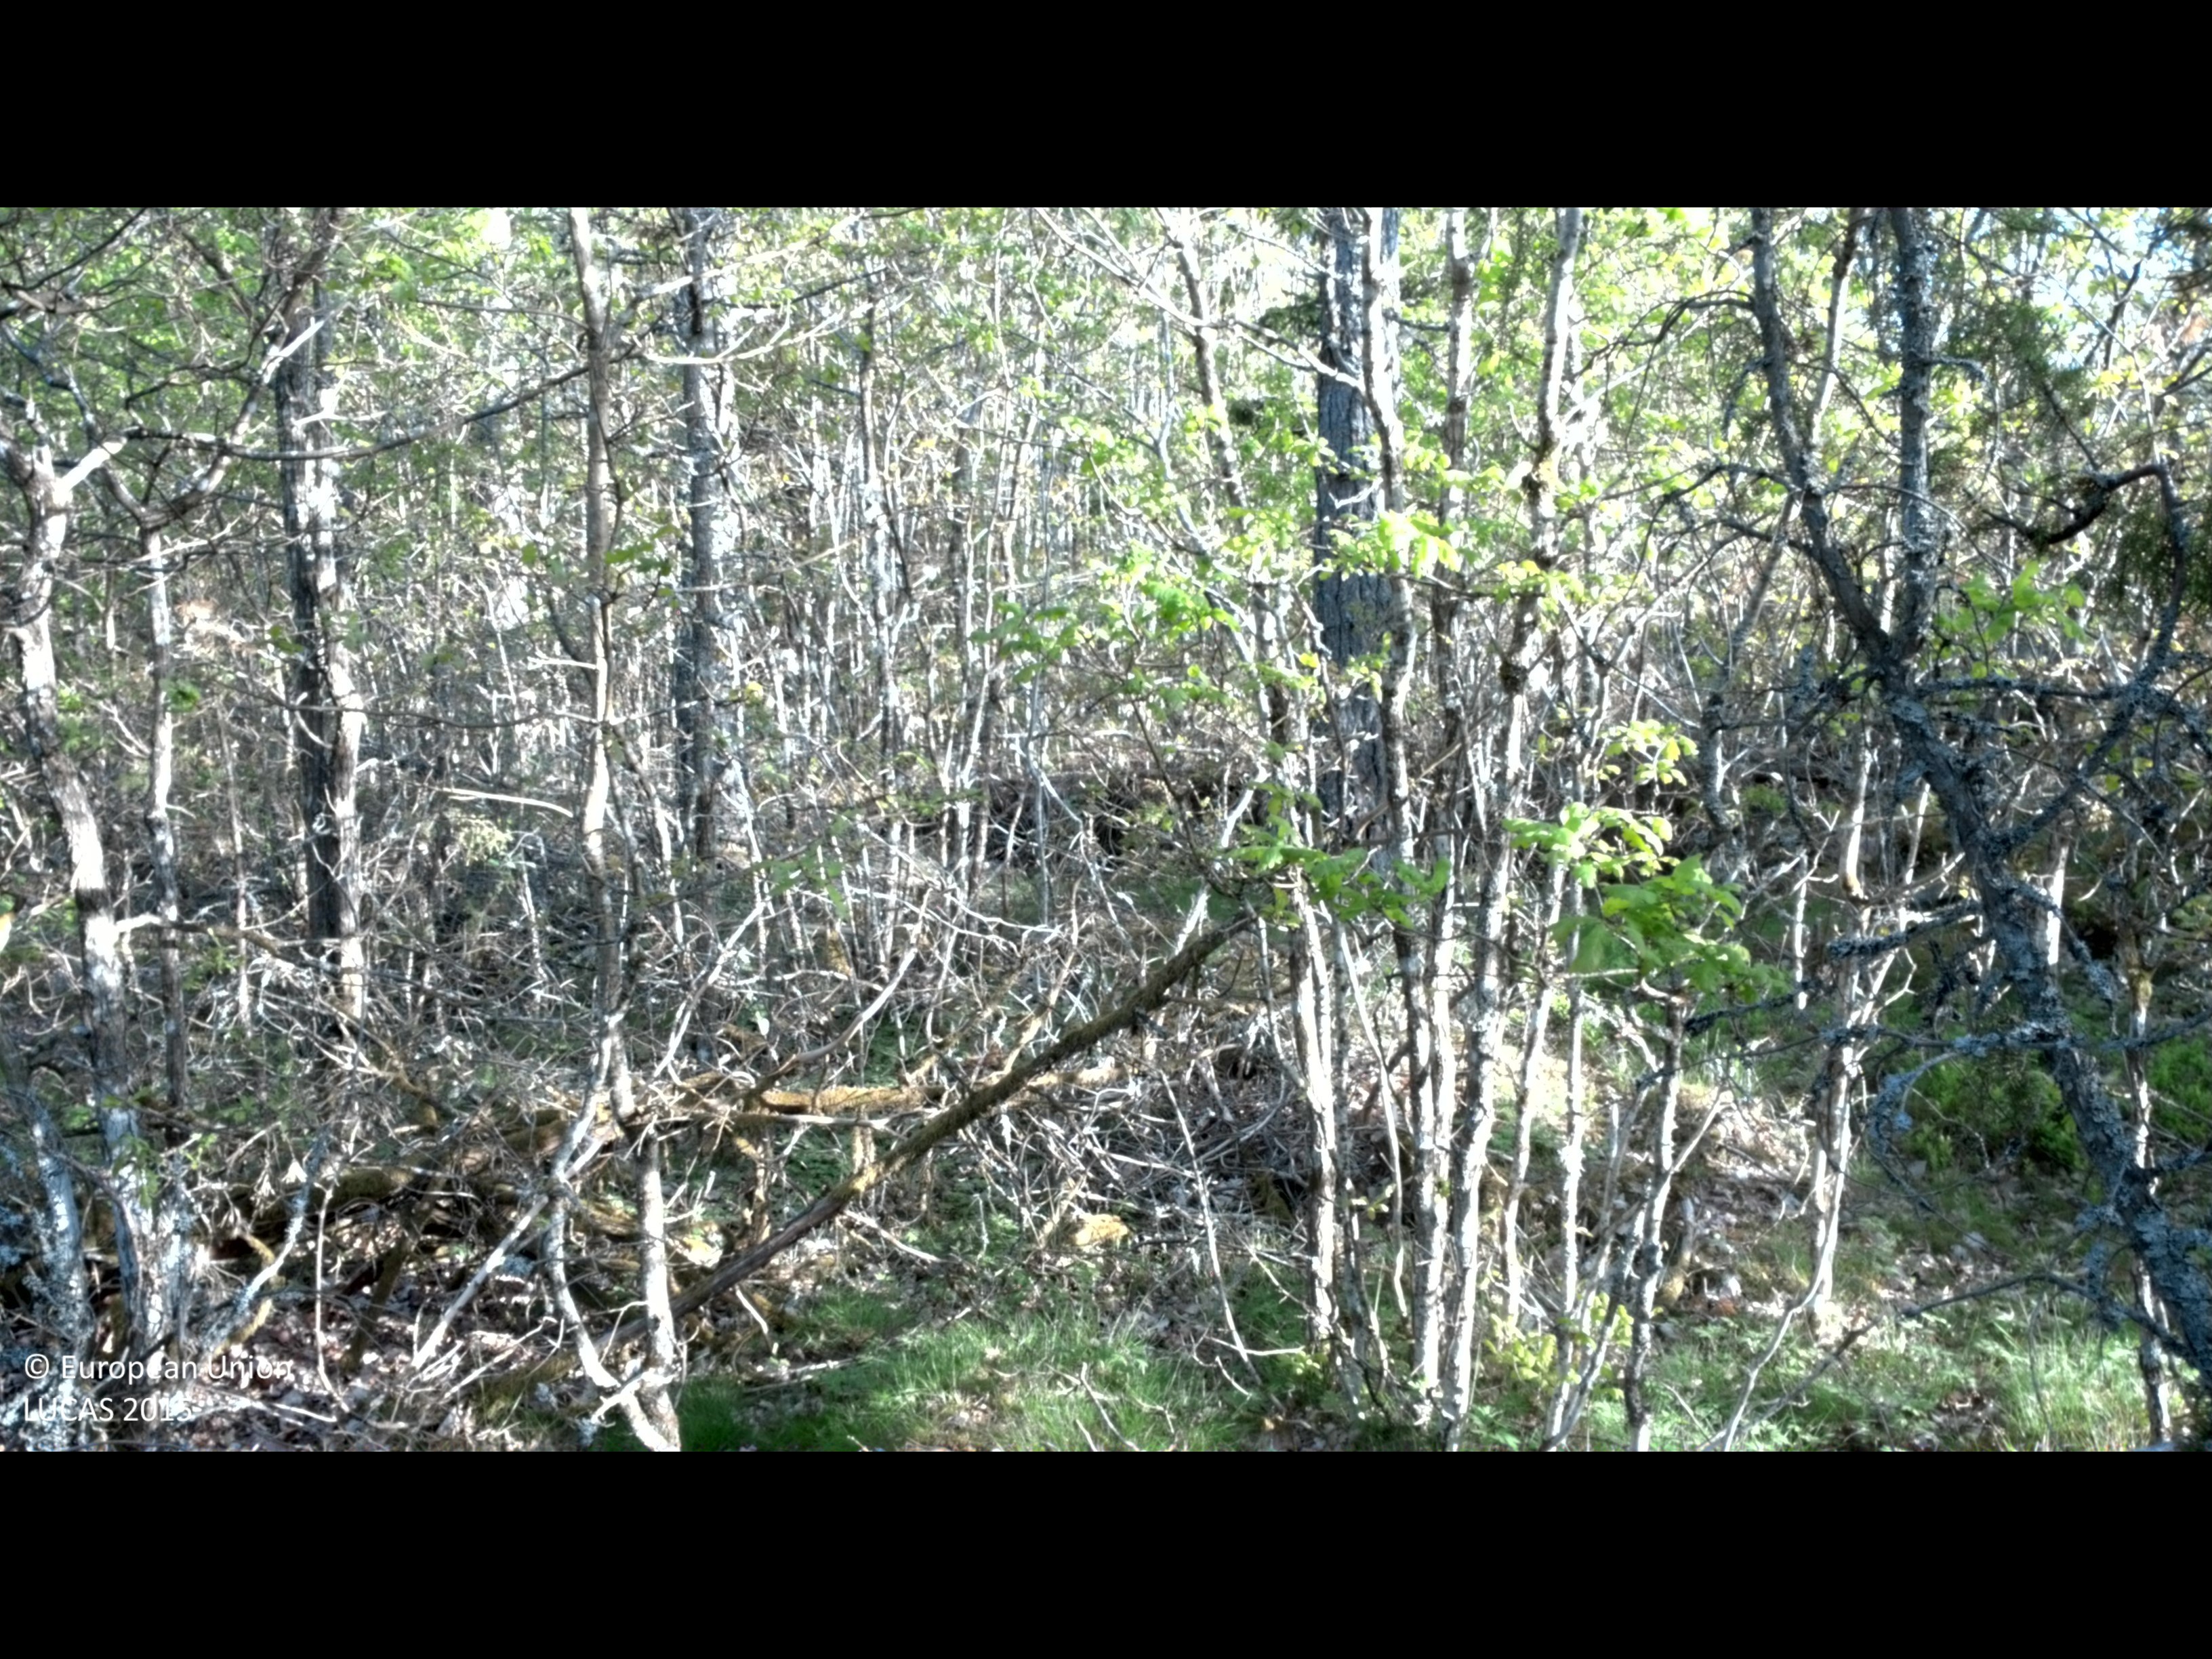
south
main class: Woodland
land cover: Pine dominated mixed woodland
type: boreal forest
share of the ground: > 75 %
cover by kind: broadleaved forest trees 60 %, coniferous forest trees 20 %, herbaceous plants 15 %, shrubs 5 %
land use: Forestry
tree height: > 5 m
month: May
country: SE
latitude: 57.3922
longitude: 16.1713
